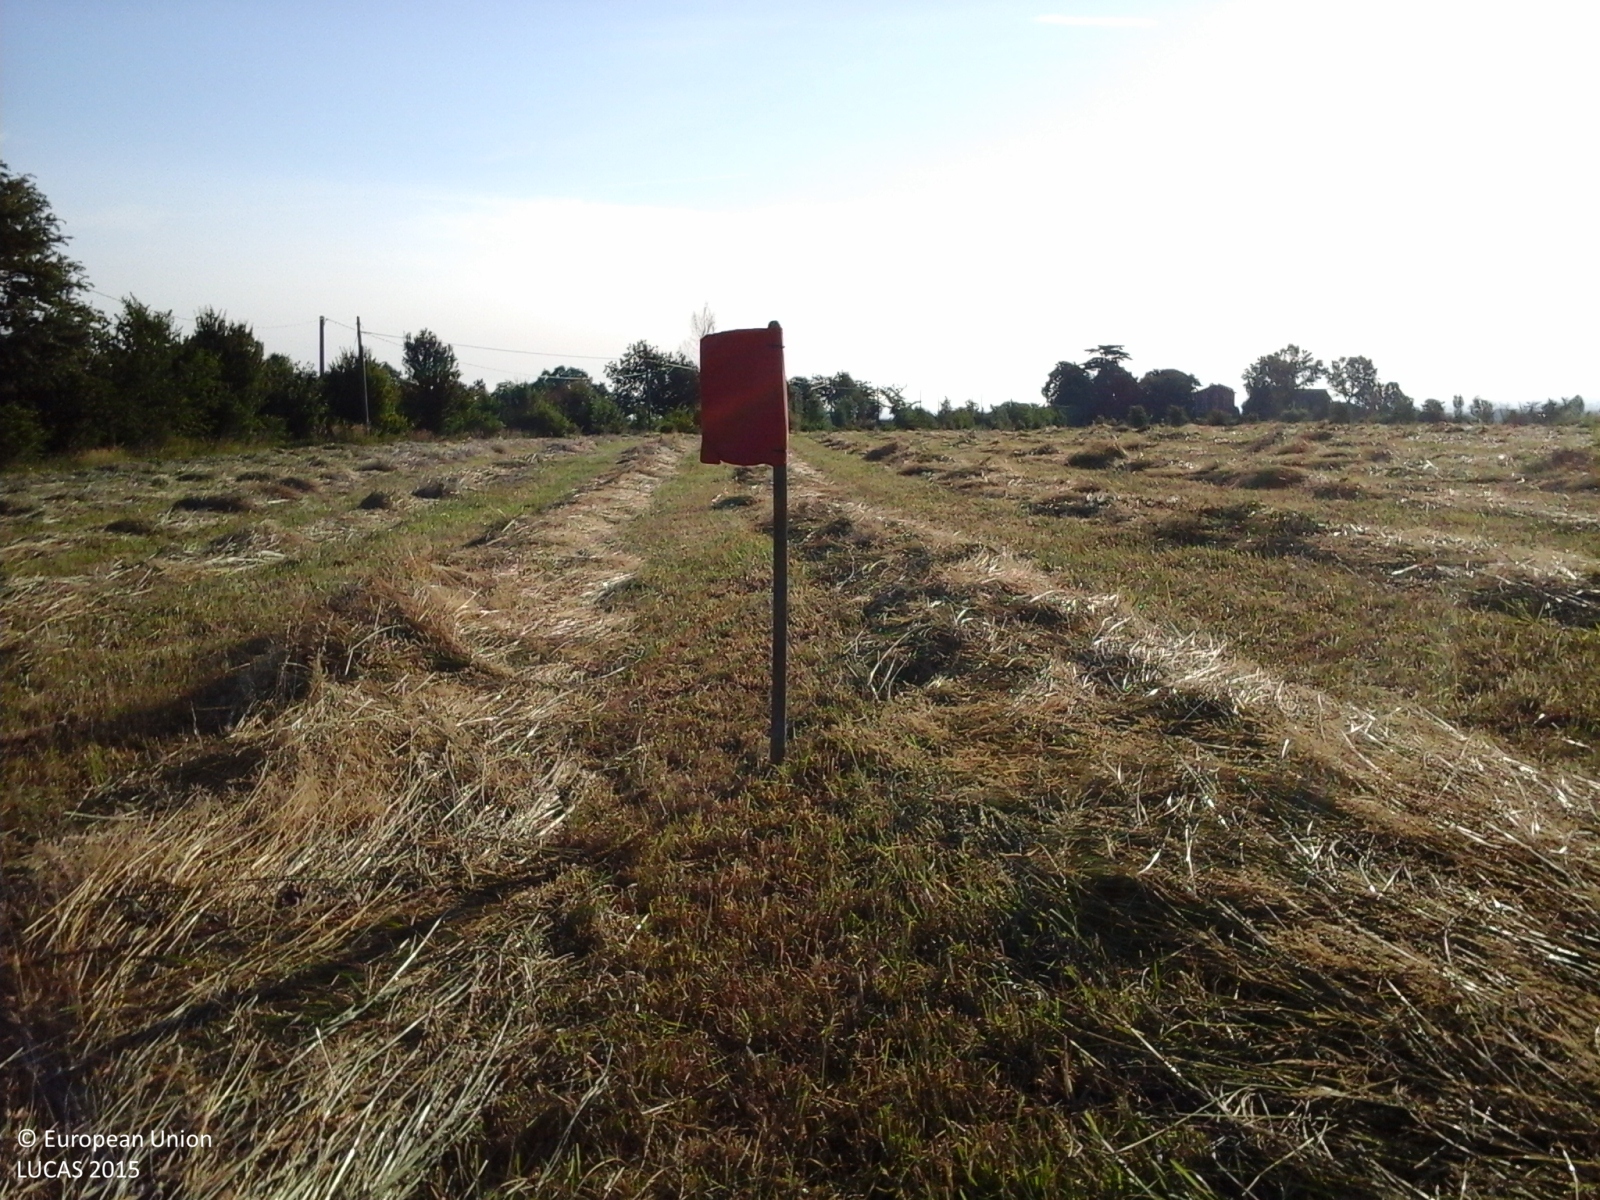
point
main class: Grassland
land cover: Grassland without tree/shrub cover
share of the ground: > 75 %
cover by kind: herbaceous plants 100 %
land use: Agriculture (excluding fallow land and kitchen gardens)
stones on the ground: < 10 %
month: May
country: IT
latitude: 44.8014
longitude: 10.0631
